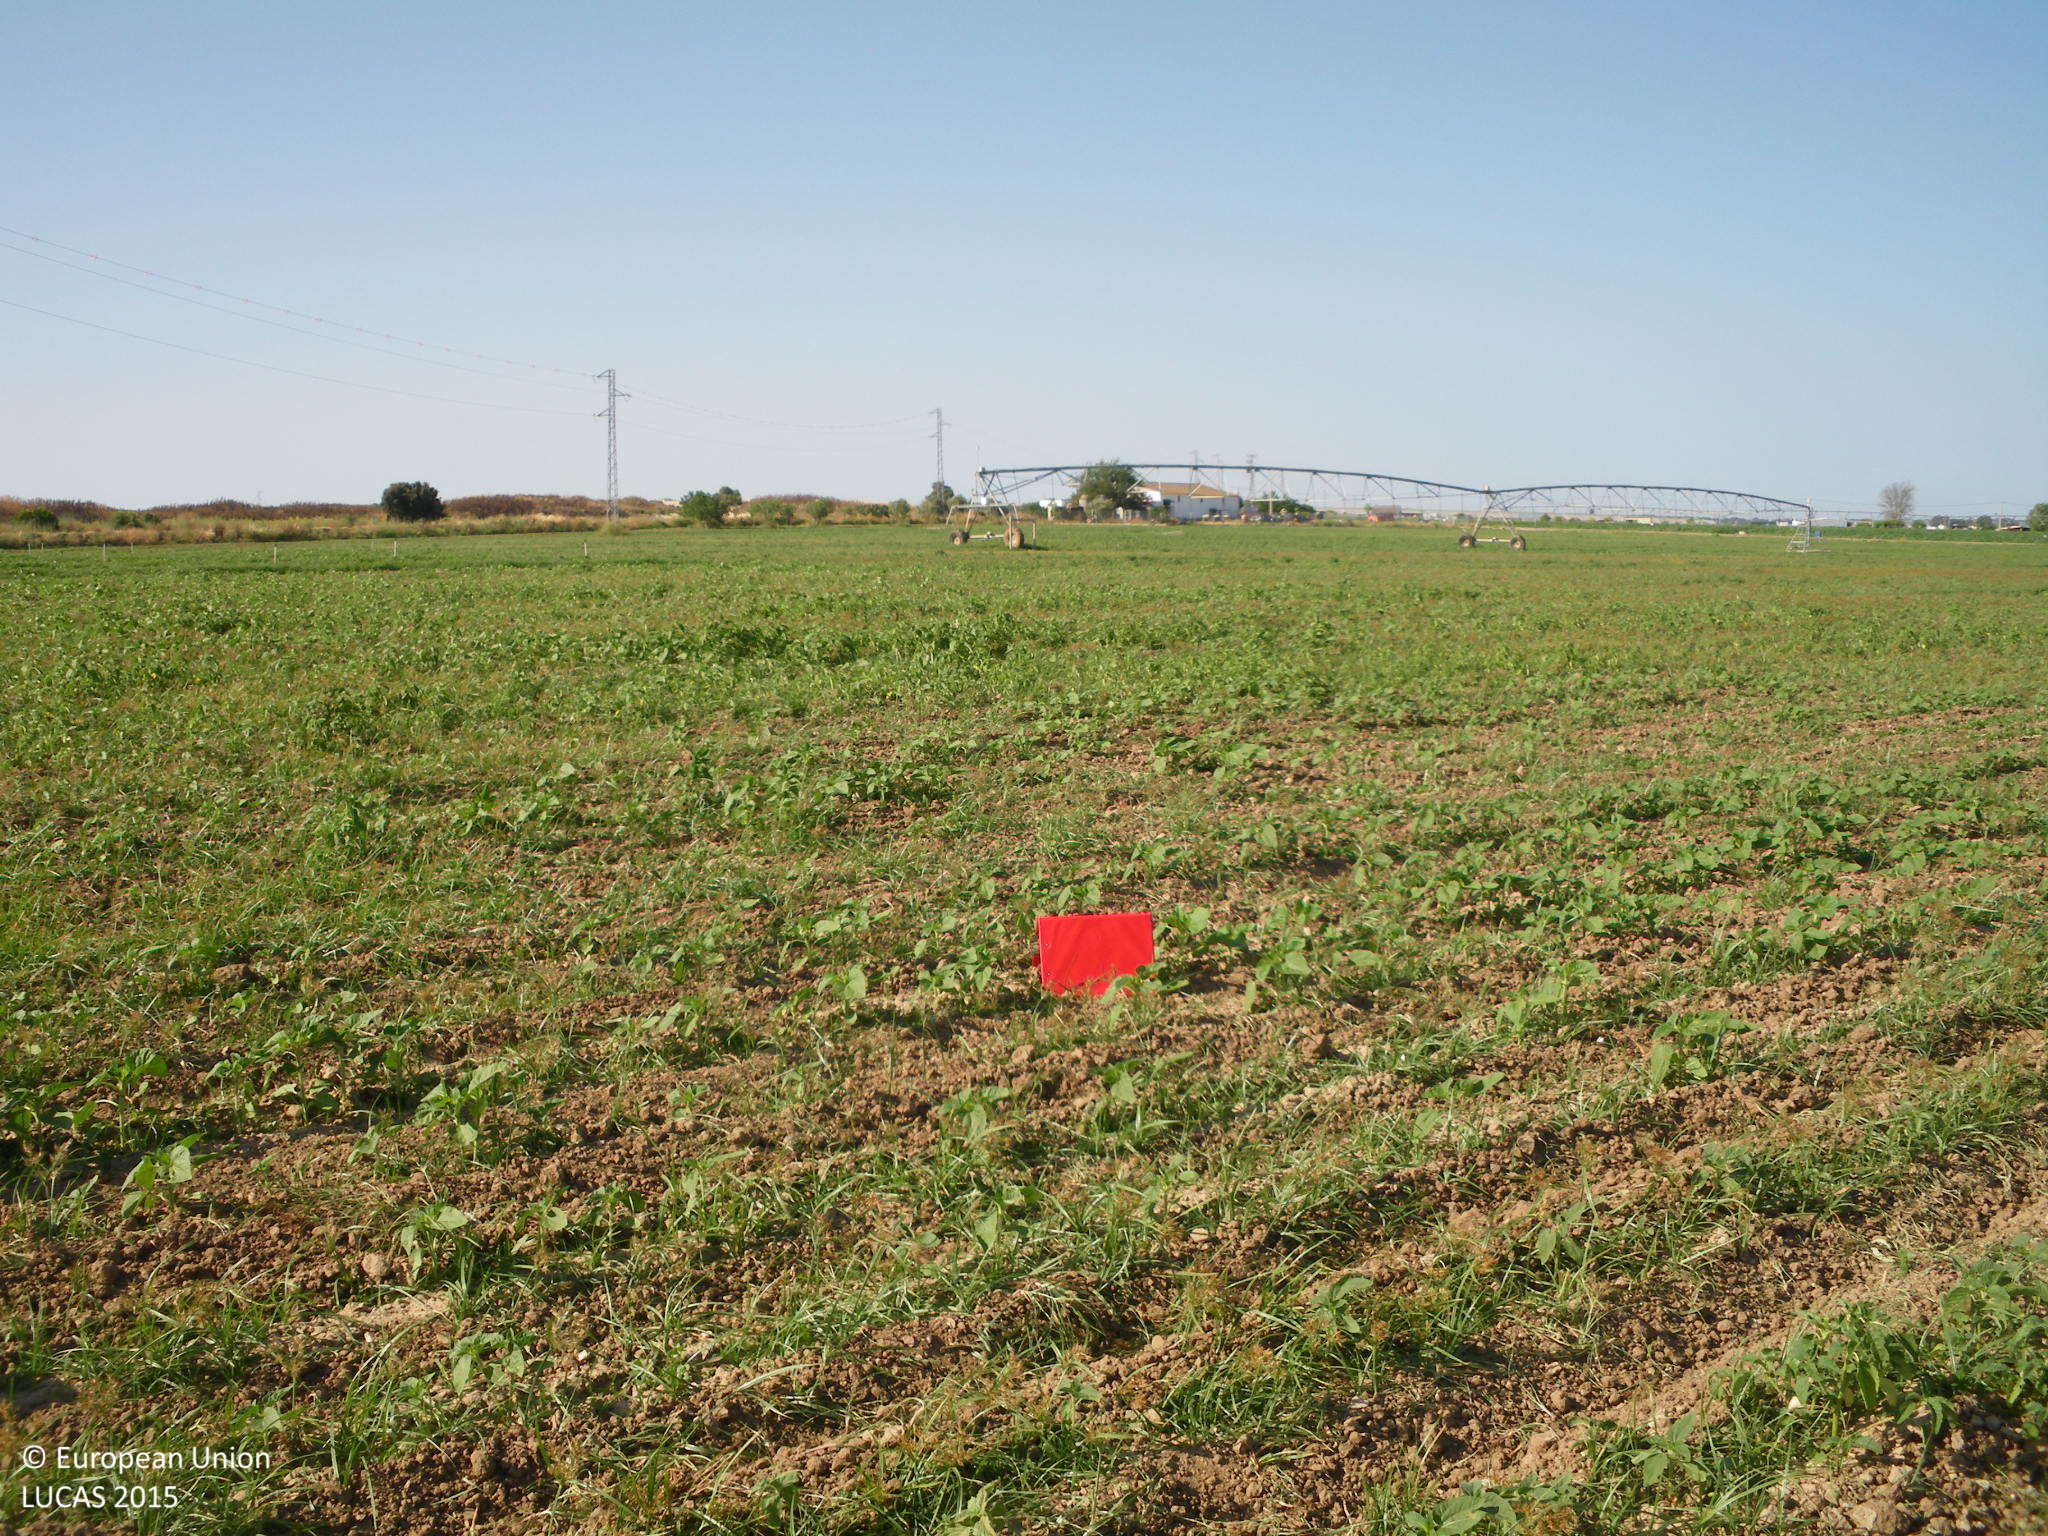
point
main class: Cropland
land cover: Sunflower
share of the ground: 10 - 25 %
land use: Agriculture (excluding fallow land and kitchen gardens)
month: June
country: ES
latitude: 36.7492
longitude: -6.0169
